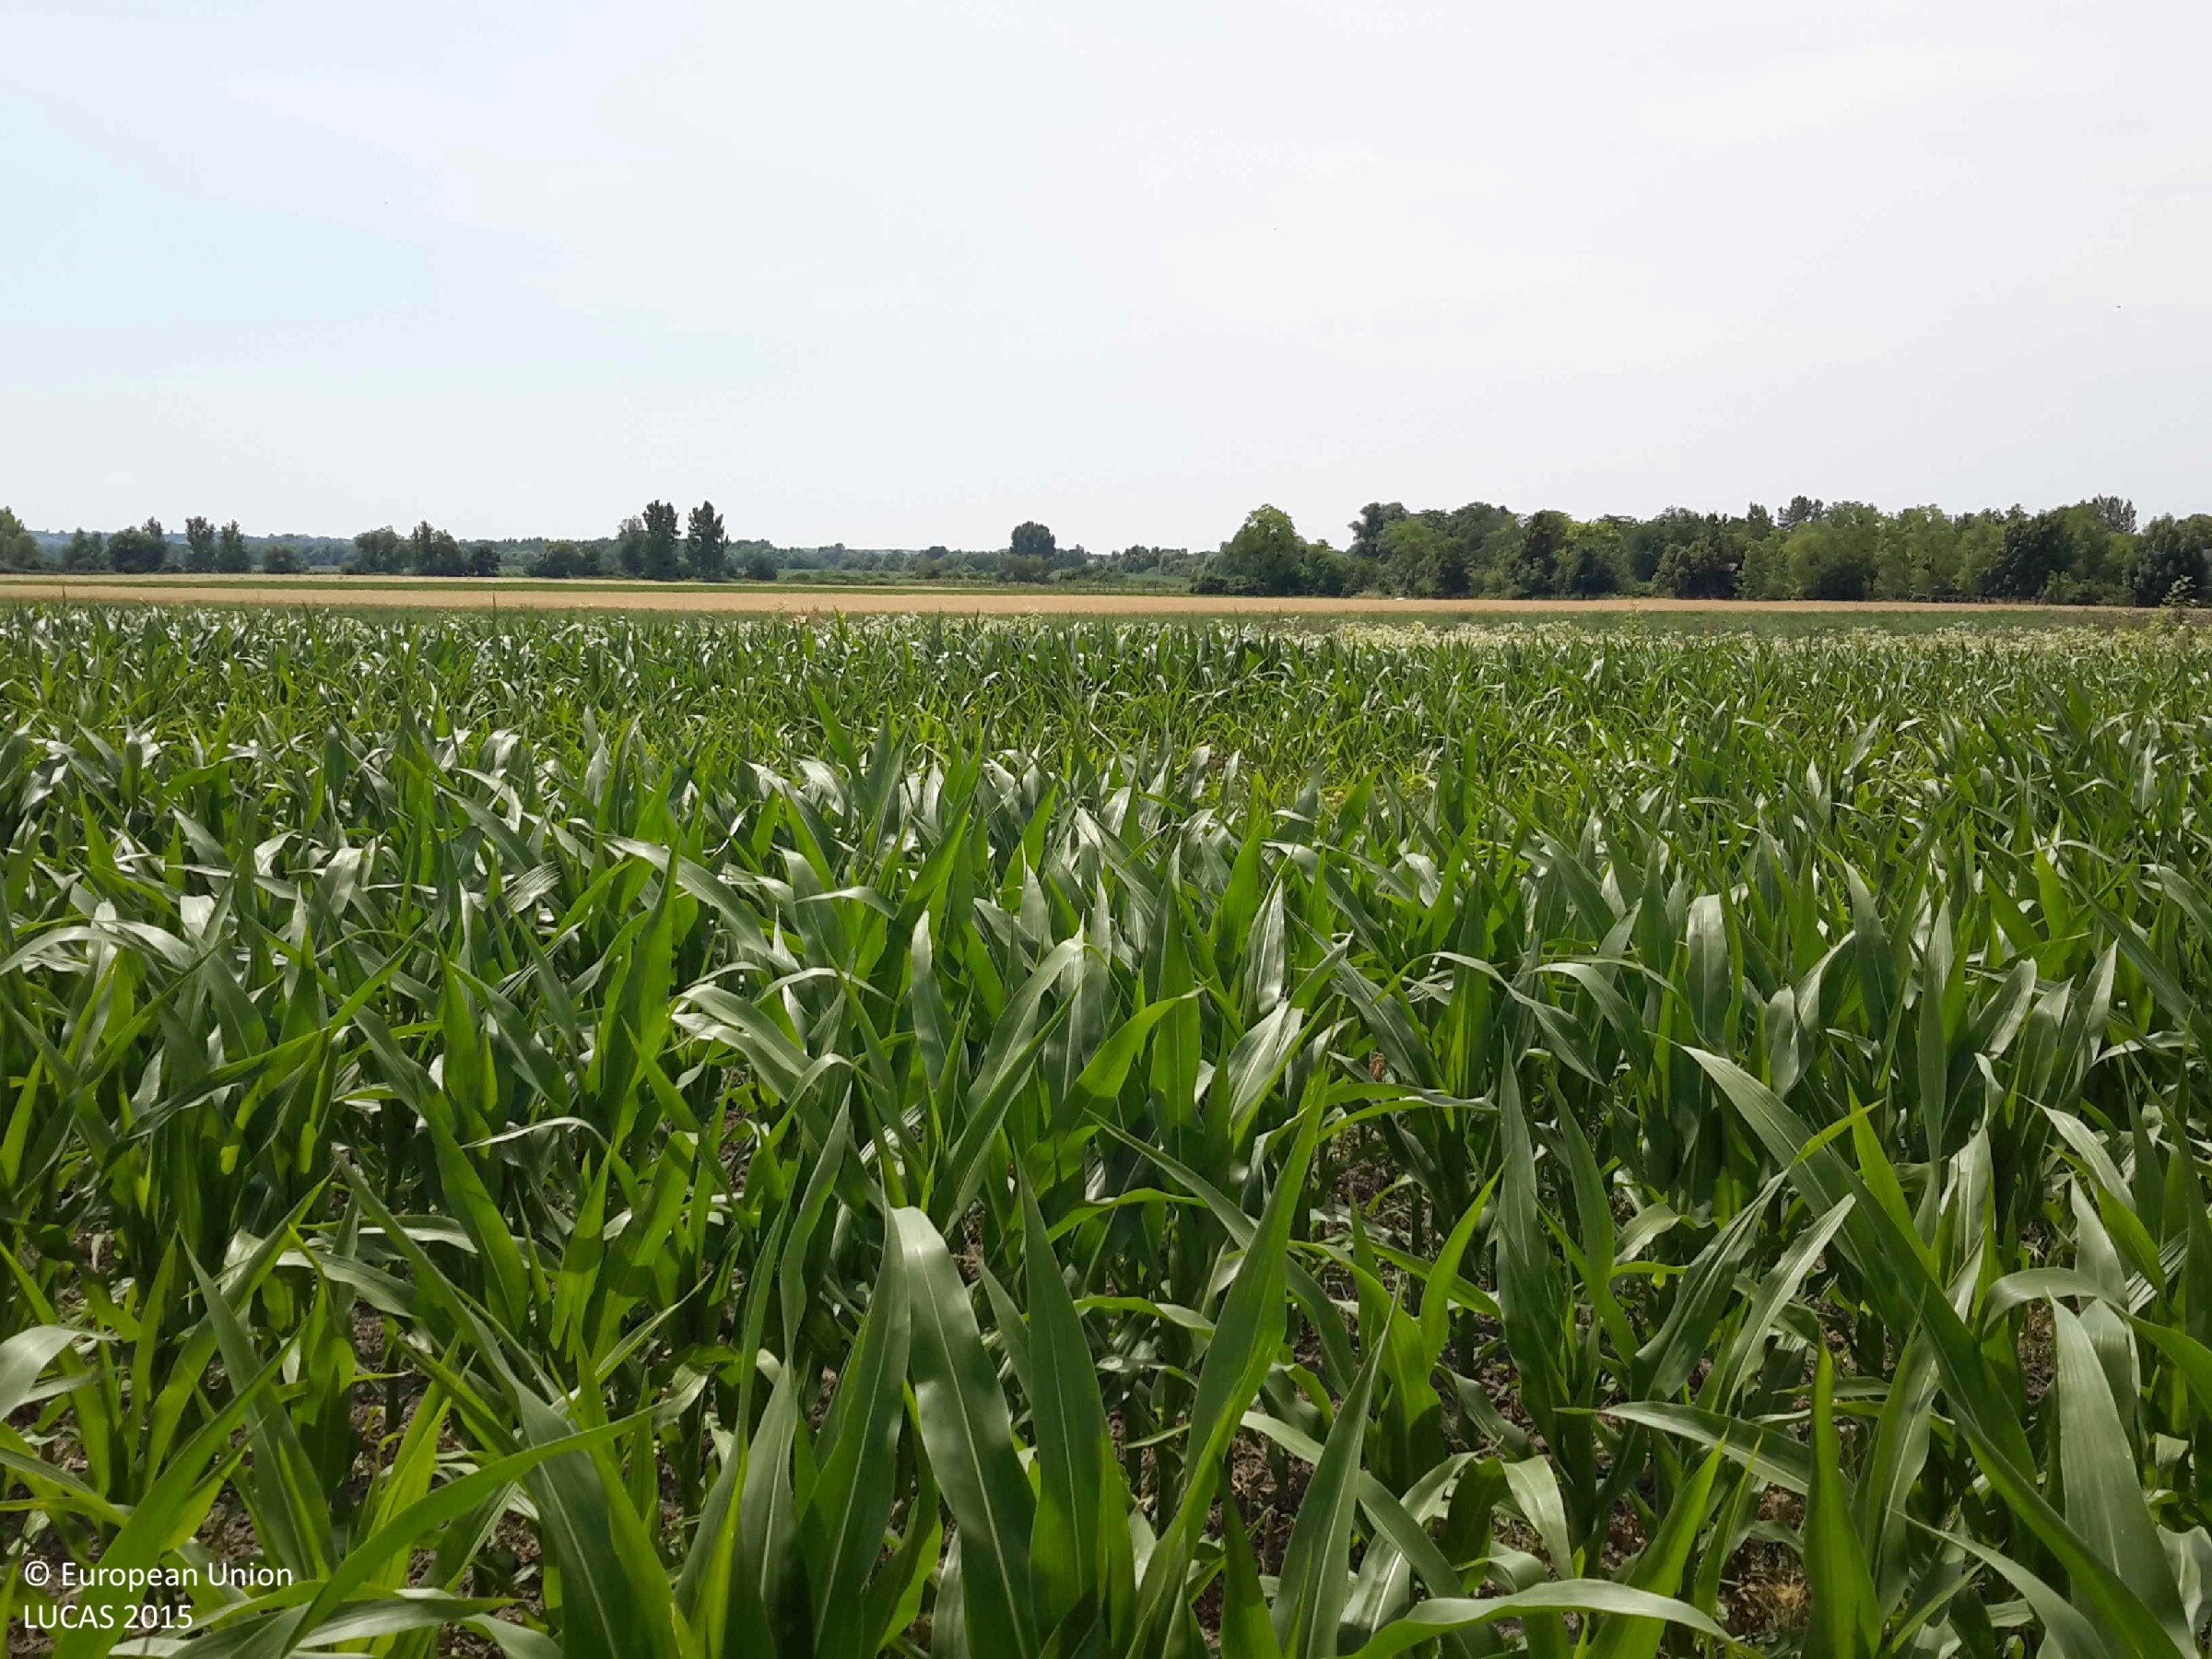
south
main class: Cropland
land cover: Maize
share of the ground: 50 - 75 %
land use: Agriculture (excluding fallow land and kitchen gardens)
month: June
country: HU
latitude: 47.3024
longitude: 17.4534
